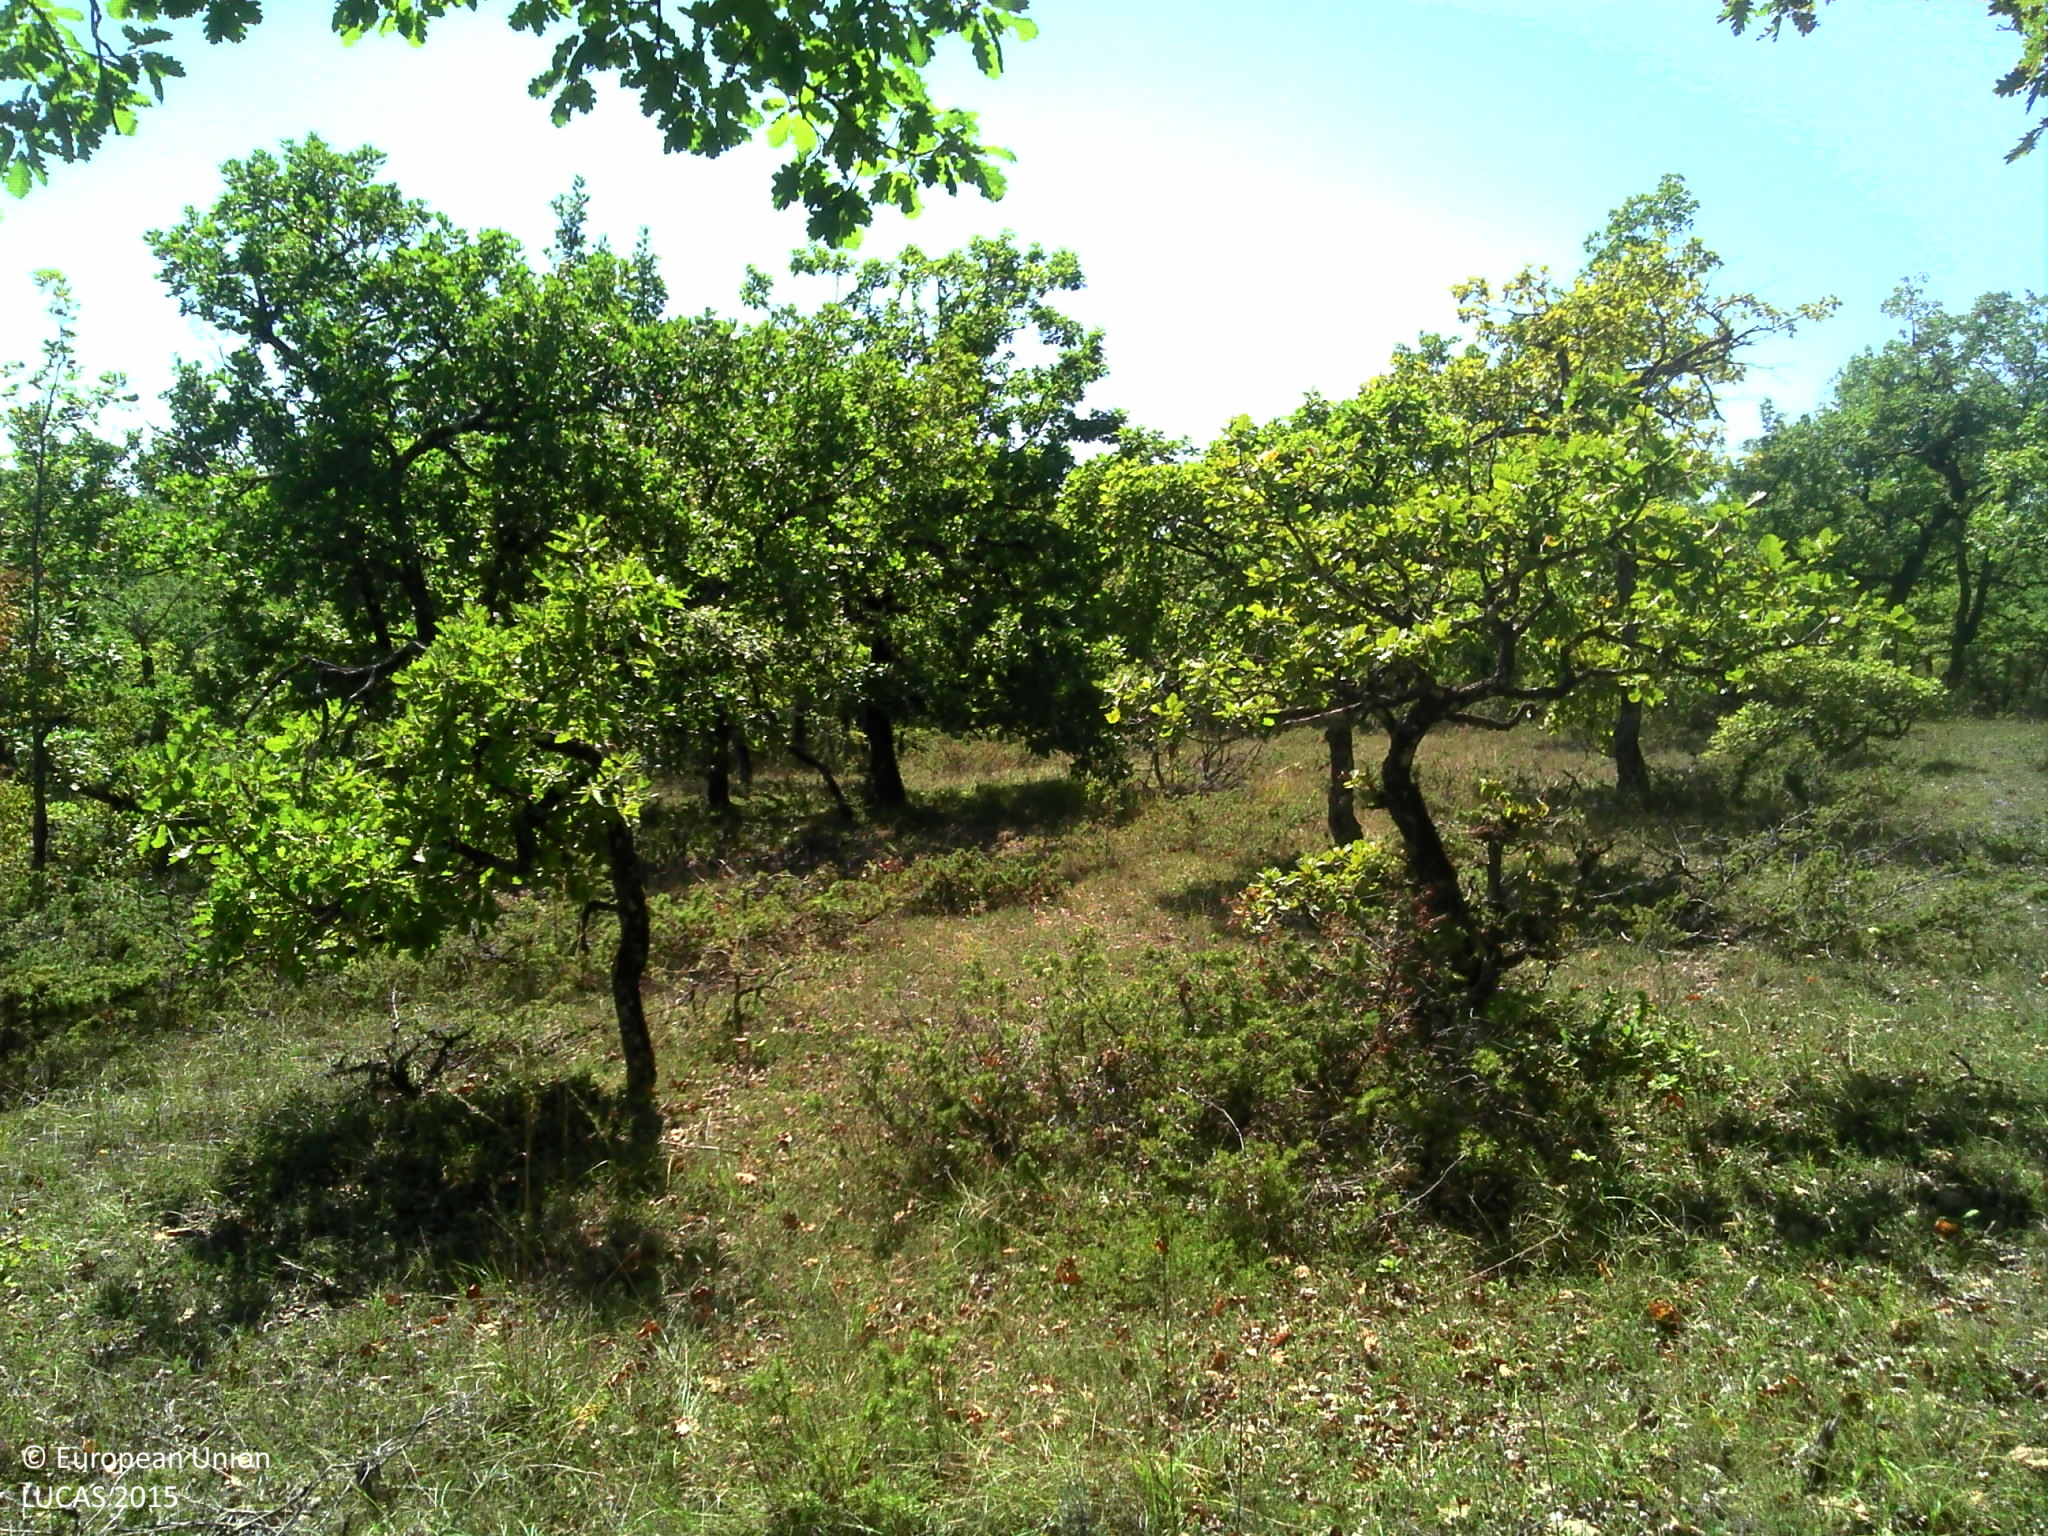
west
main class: Woodland
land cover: Broadleaved woodland
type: thermophilous deciduous forest
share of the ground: > 75 %
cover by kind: broadleaved forest trees 50 %, herbaceous plants 35 %, shrubs 10 %, lichens and mosses 5 %
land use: Forestry
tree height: > 5 m
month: August
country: FR
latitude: 44.3263
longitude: 1.4845
